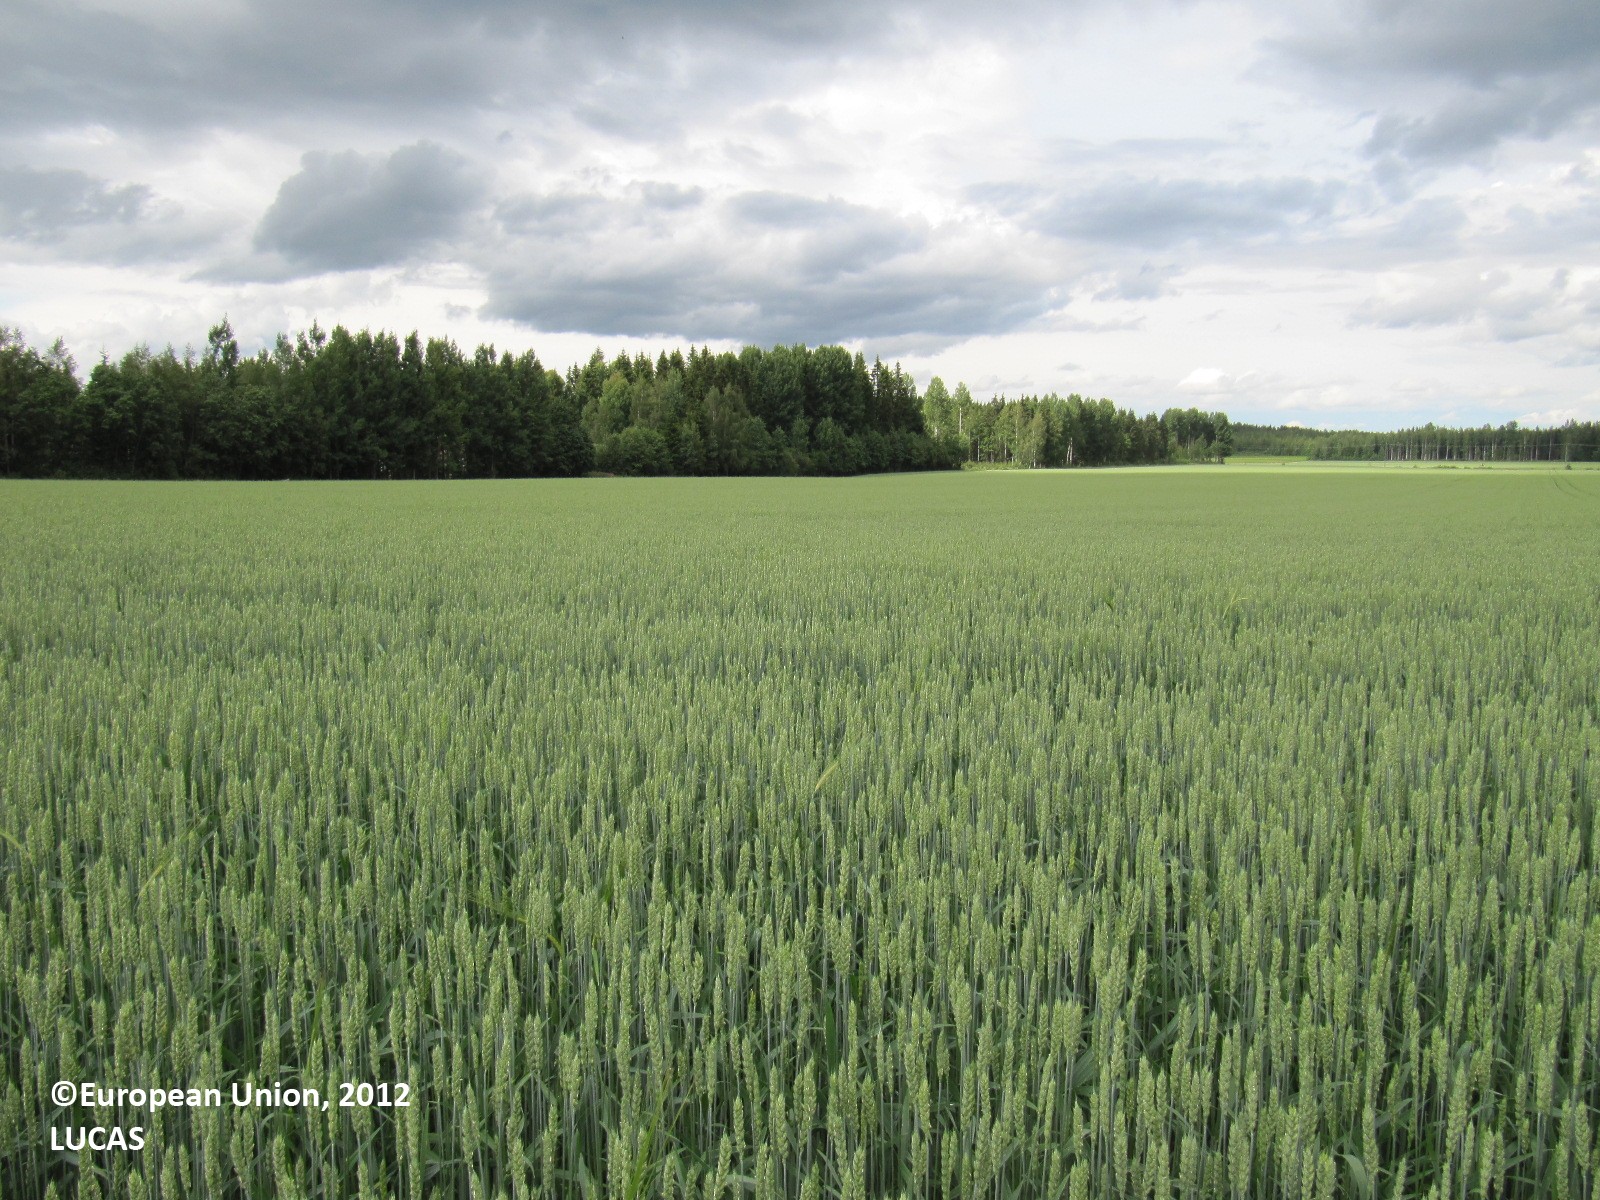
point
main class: Cropland
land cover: Common wheat
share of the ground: > 75 %
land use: Agriculture (excluding fallow land and kitchen gardens)
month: July
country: FI
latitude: 60.9112
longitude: 24.6930
